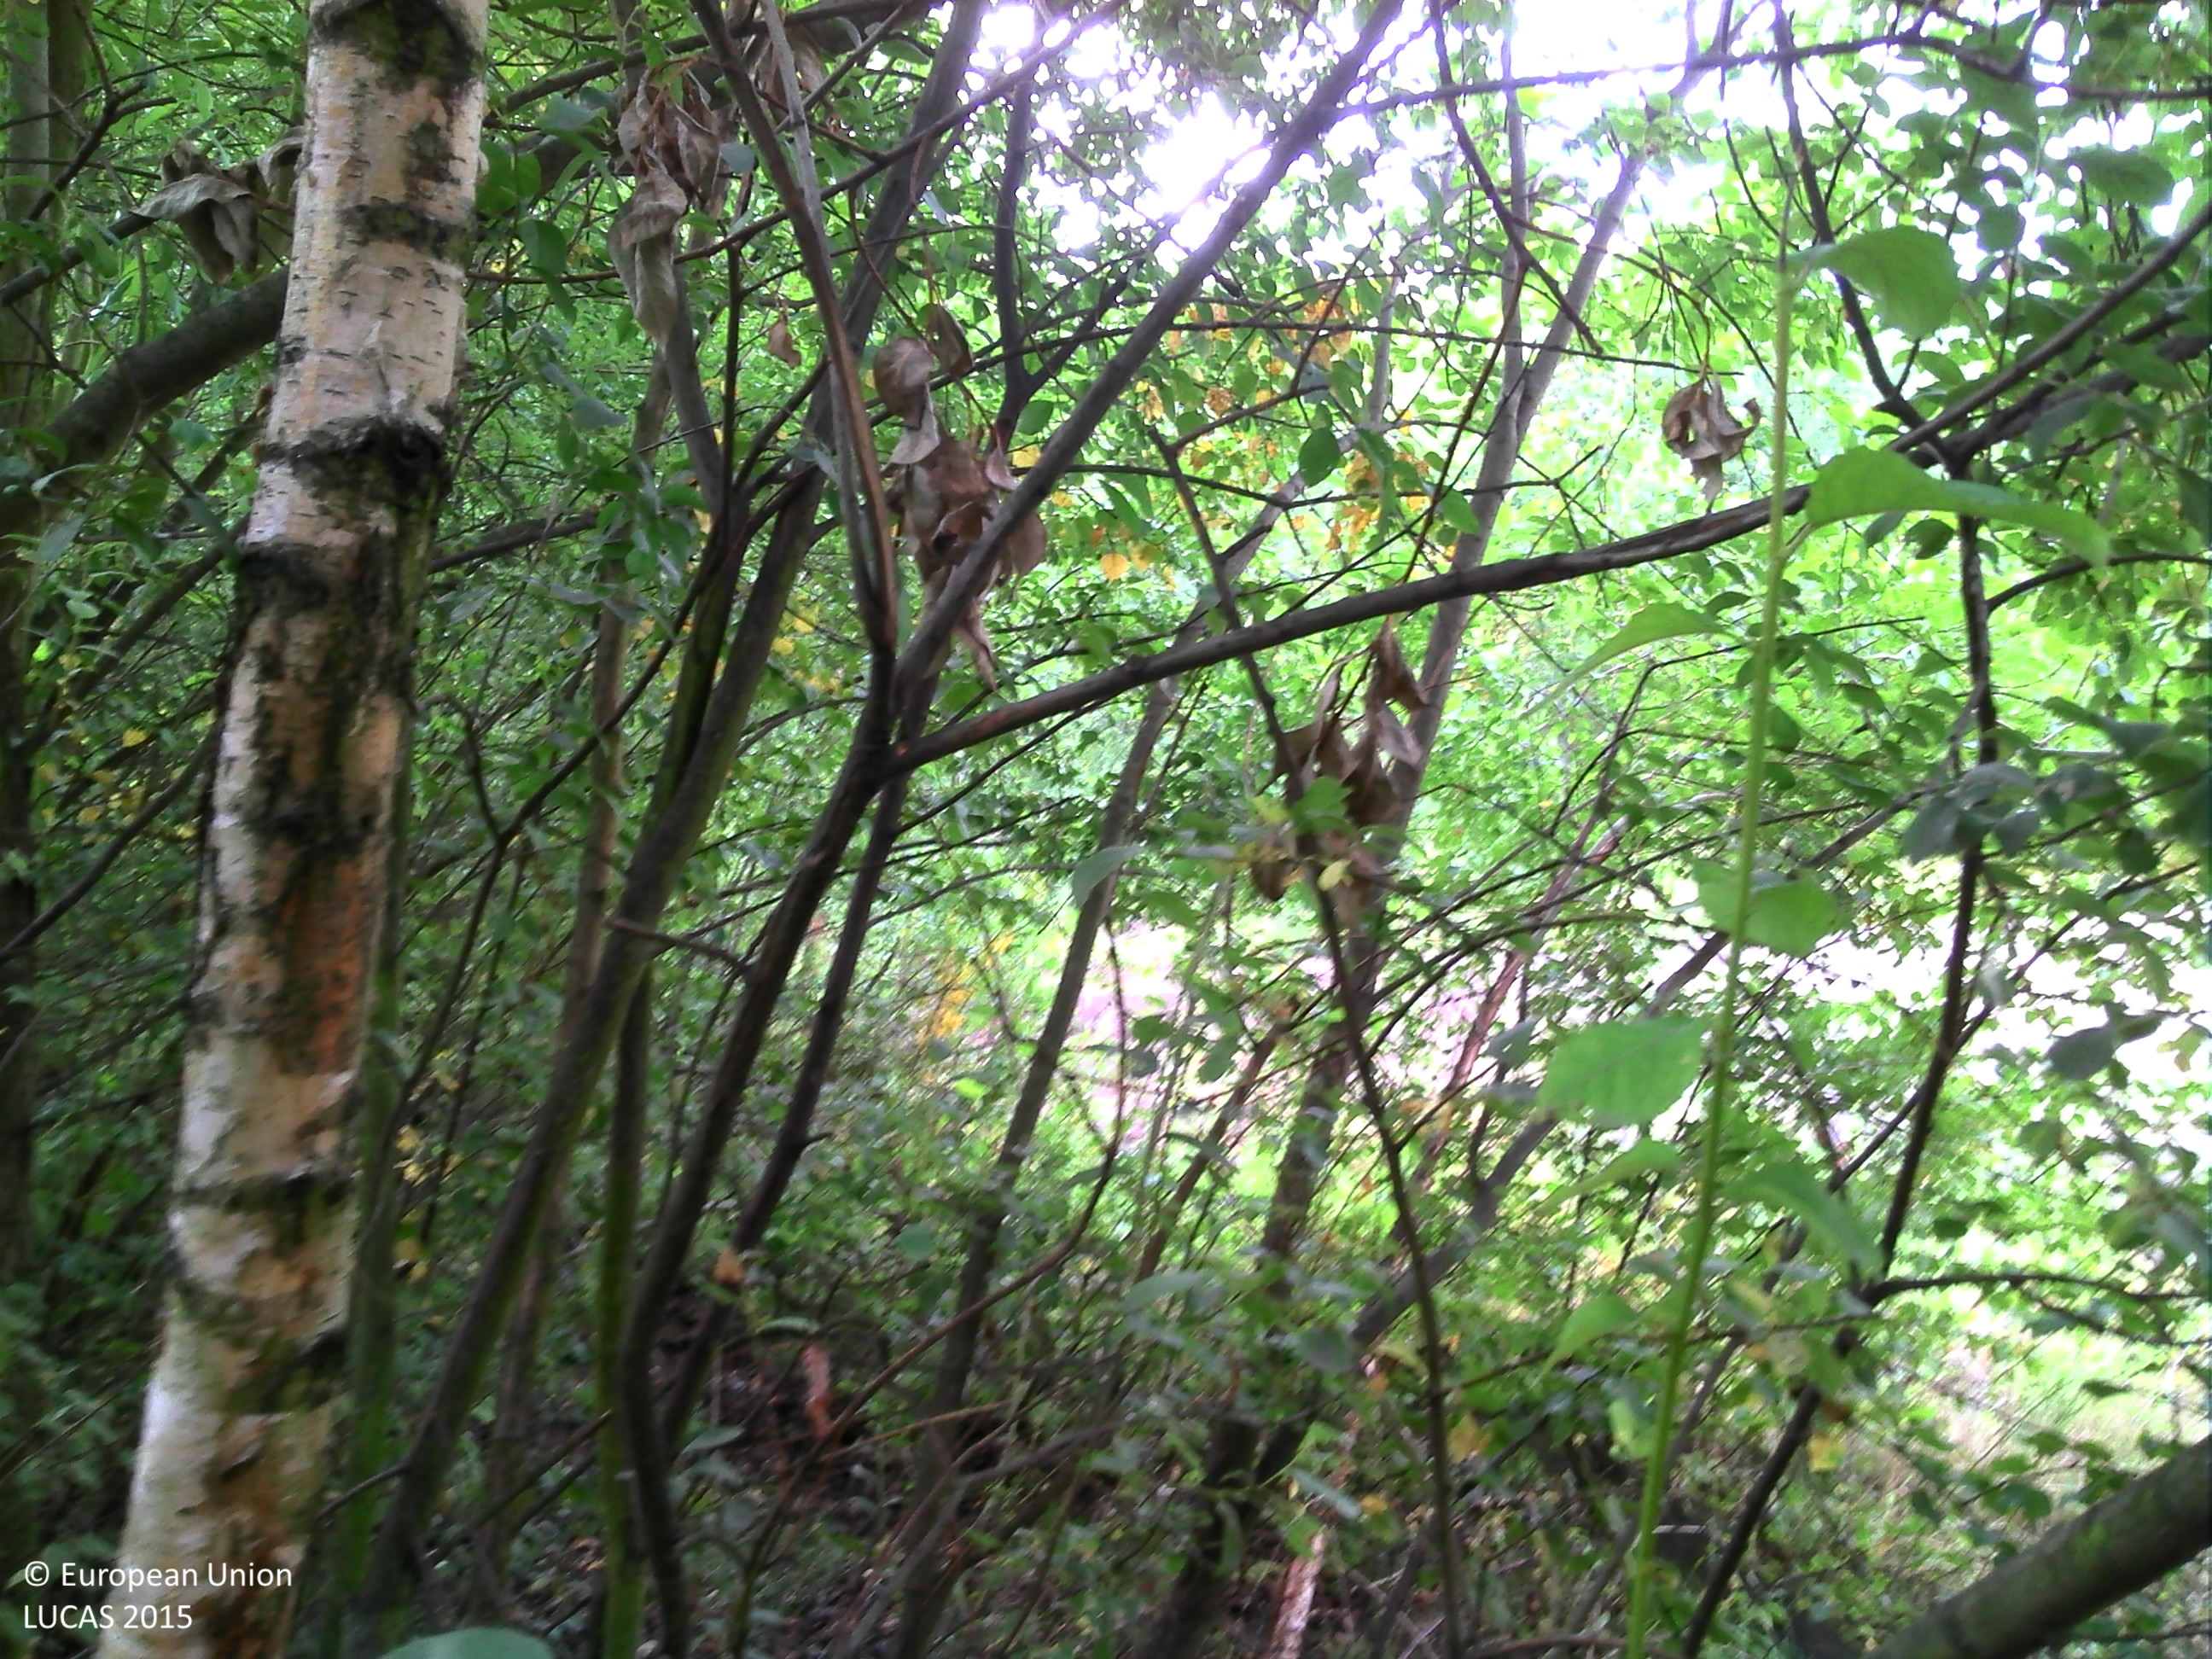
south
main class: Woodland
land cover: Broadleaved woodland
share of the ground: > 75 %
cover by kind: broadleaved forest trees 80 %, herbaceous plants 20 %
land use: Semi-natural and natural areas not in use
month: June
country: BE
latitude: 51.0722
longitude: 5.1593
